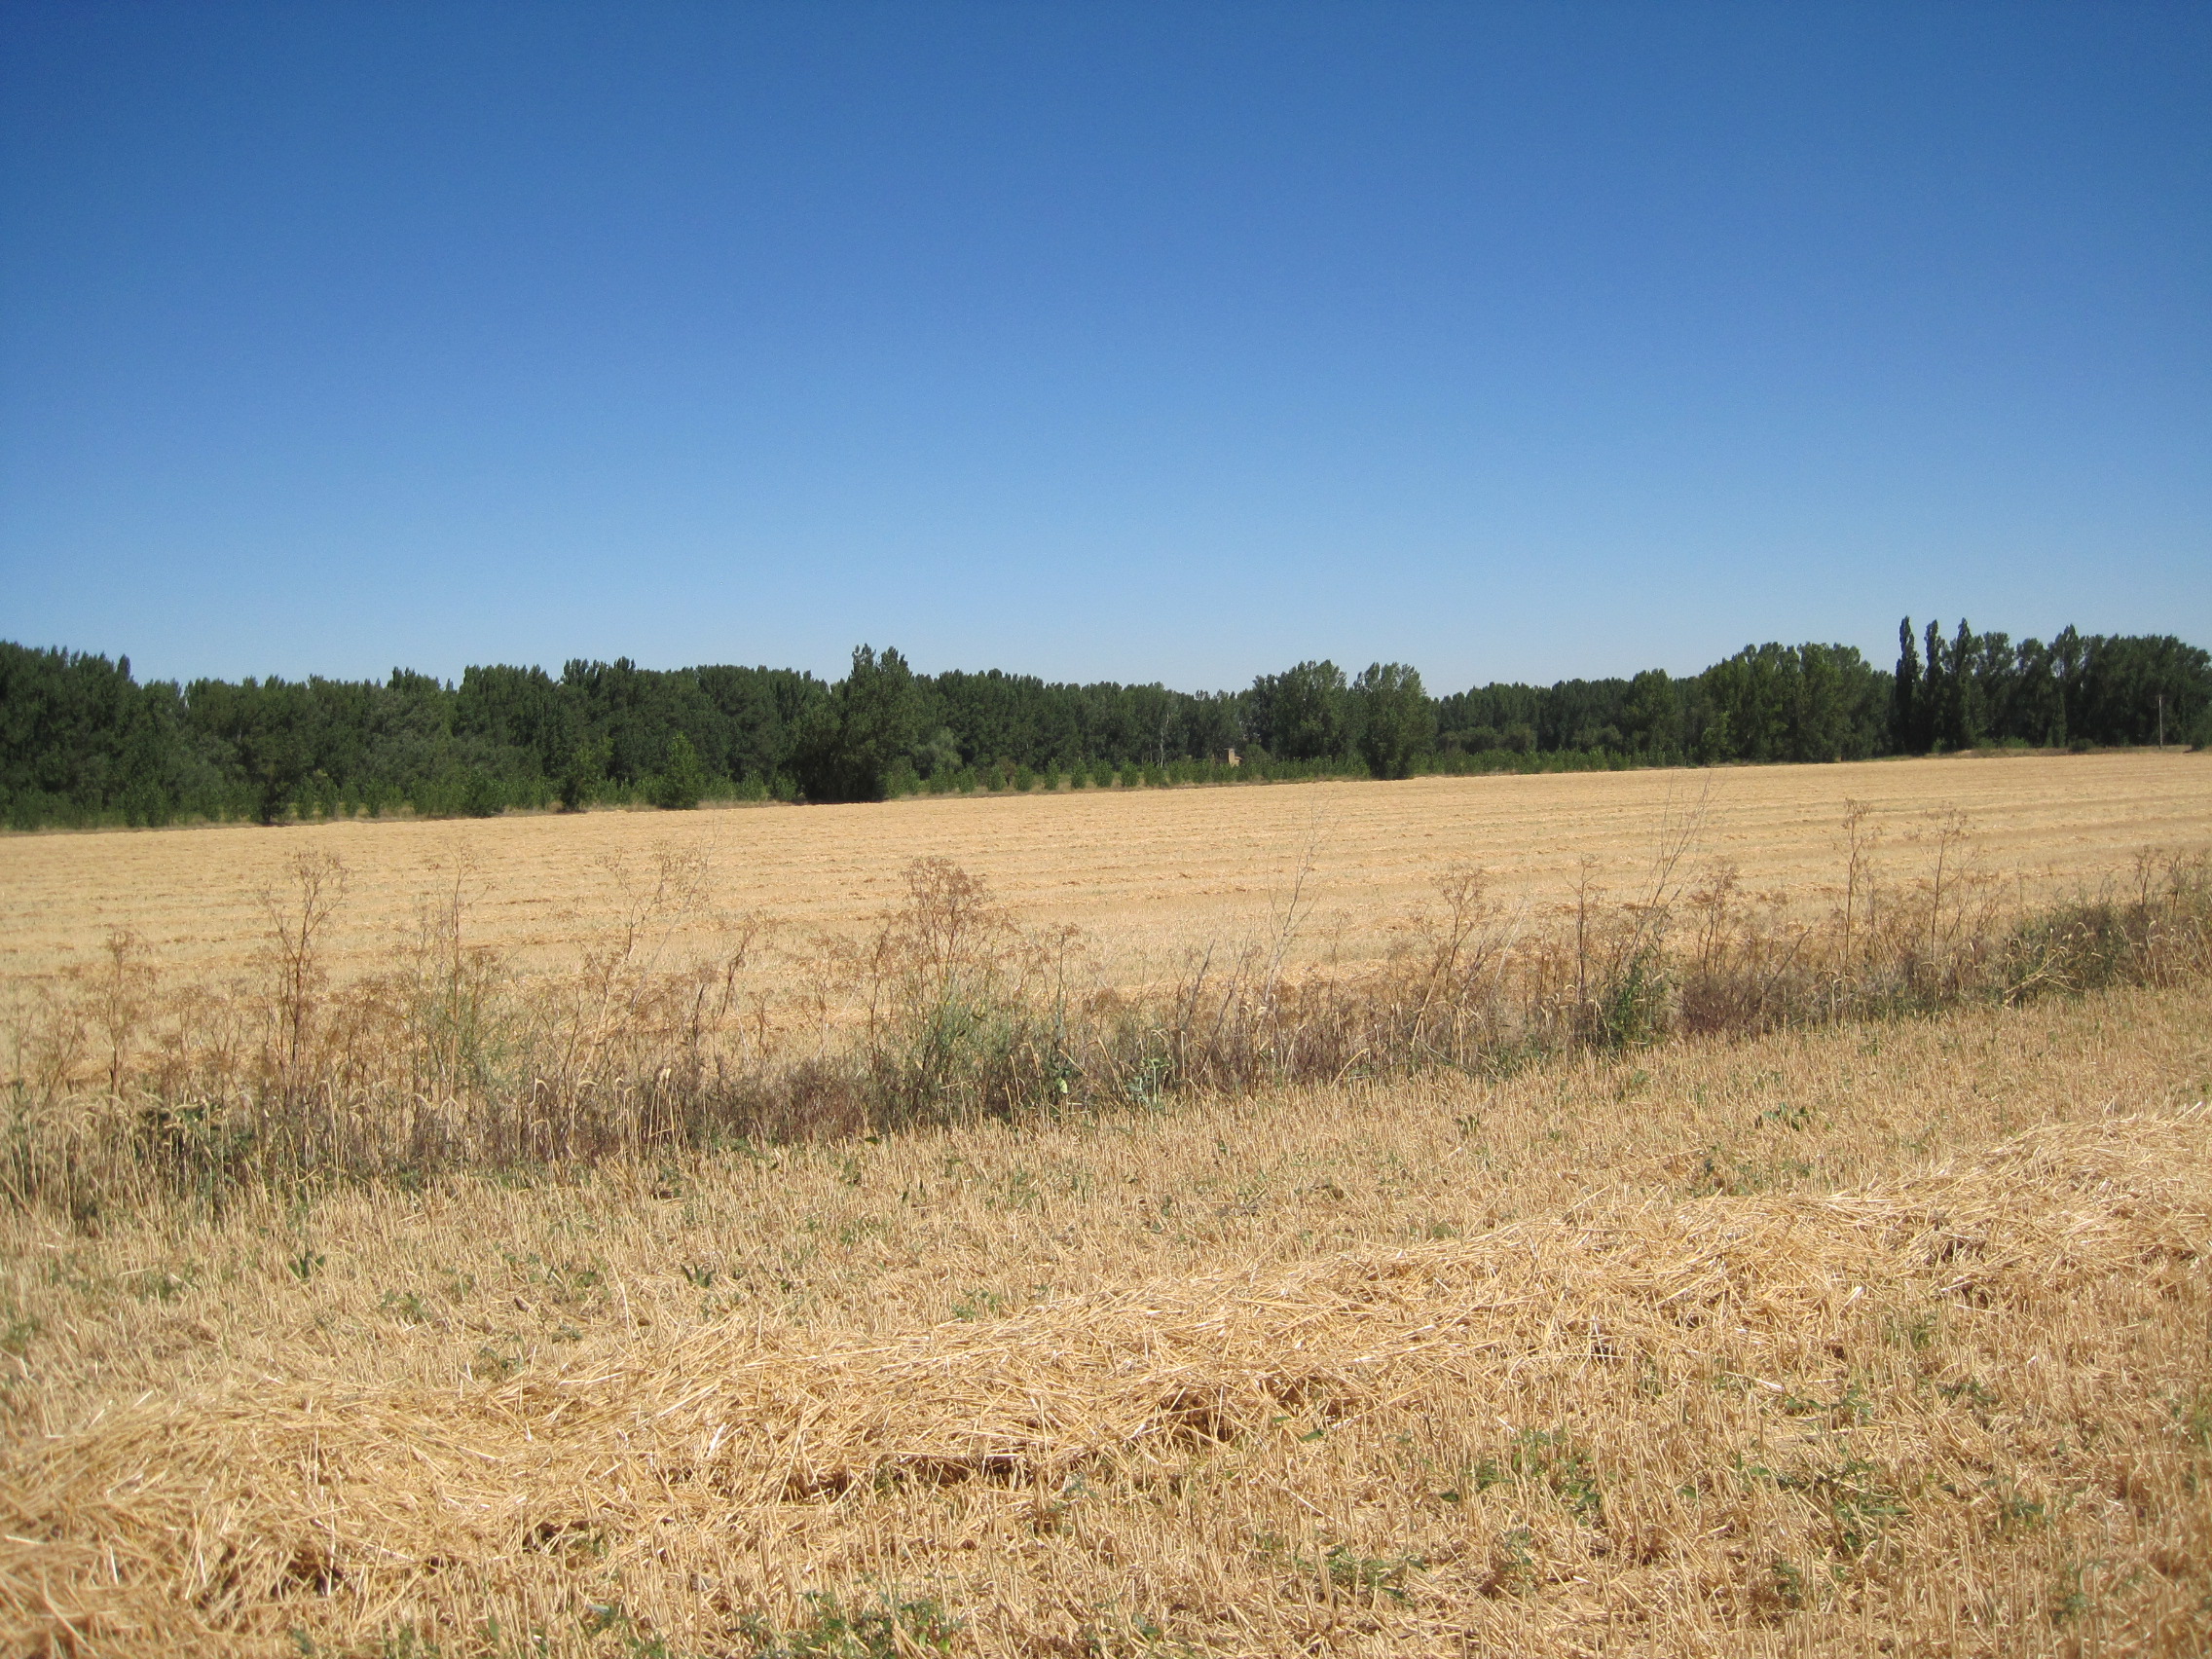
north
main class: Cropland
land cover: Common wheat
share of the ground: < 10 %
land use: Agriculture (excluding fallow land and kitchen gardens)
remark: Harvested field
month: July
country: ES
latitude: 42.1448
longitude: -5.2960
